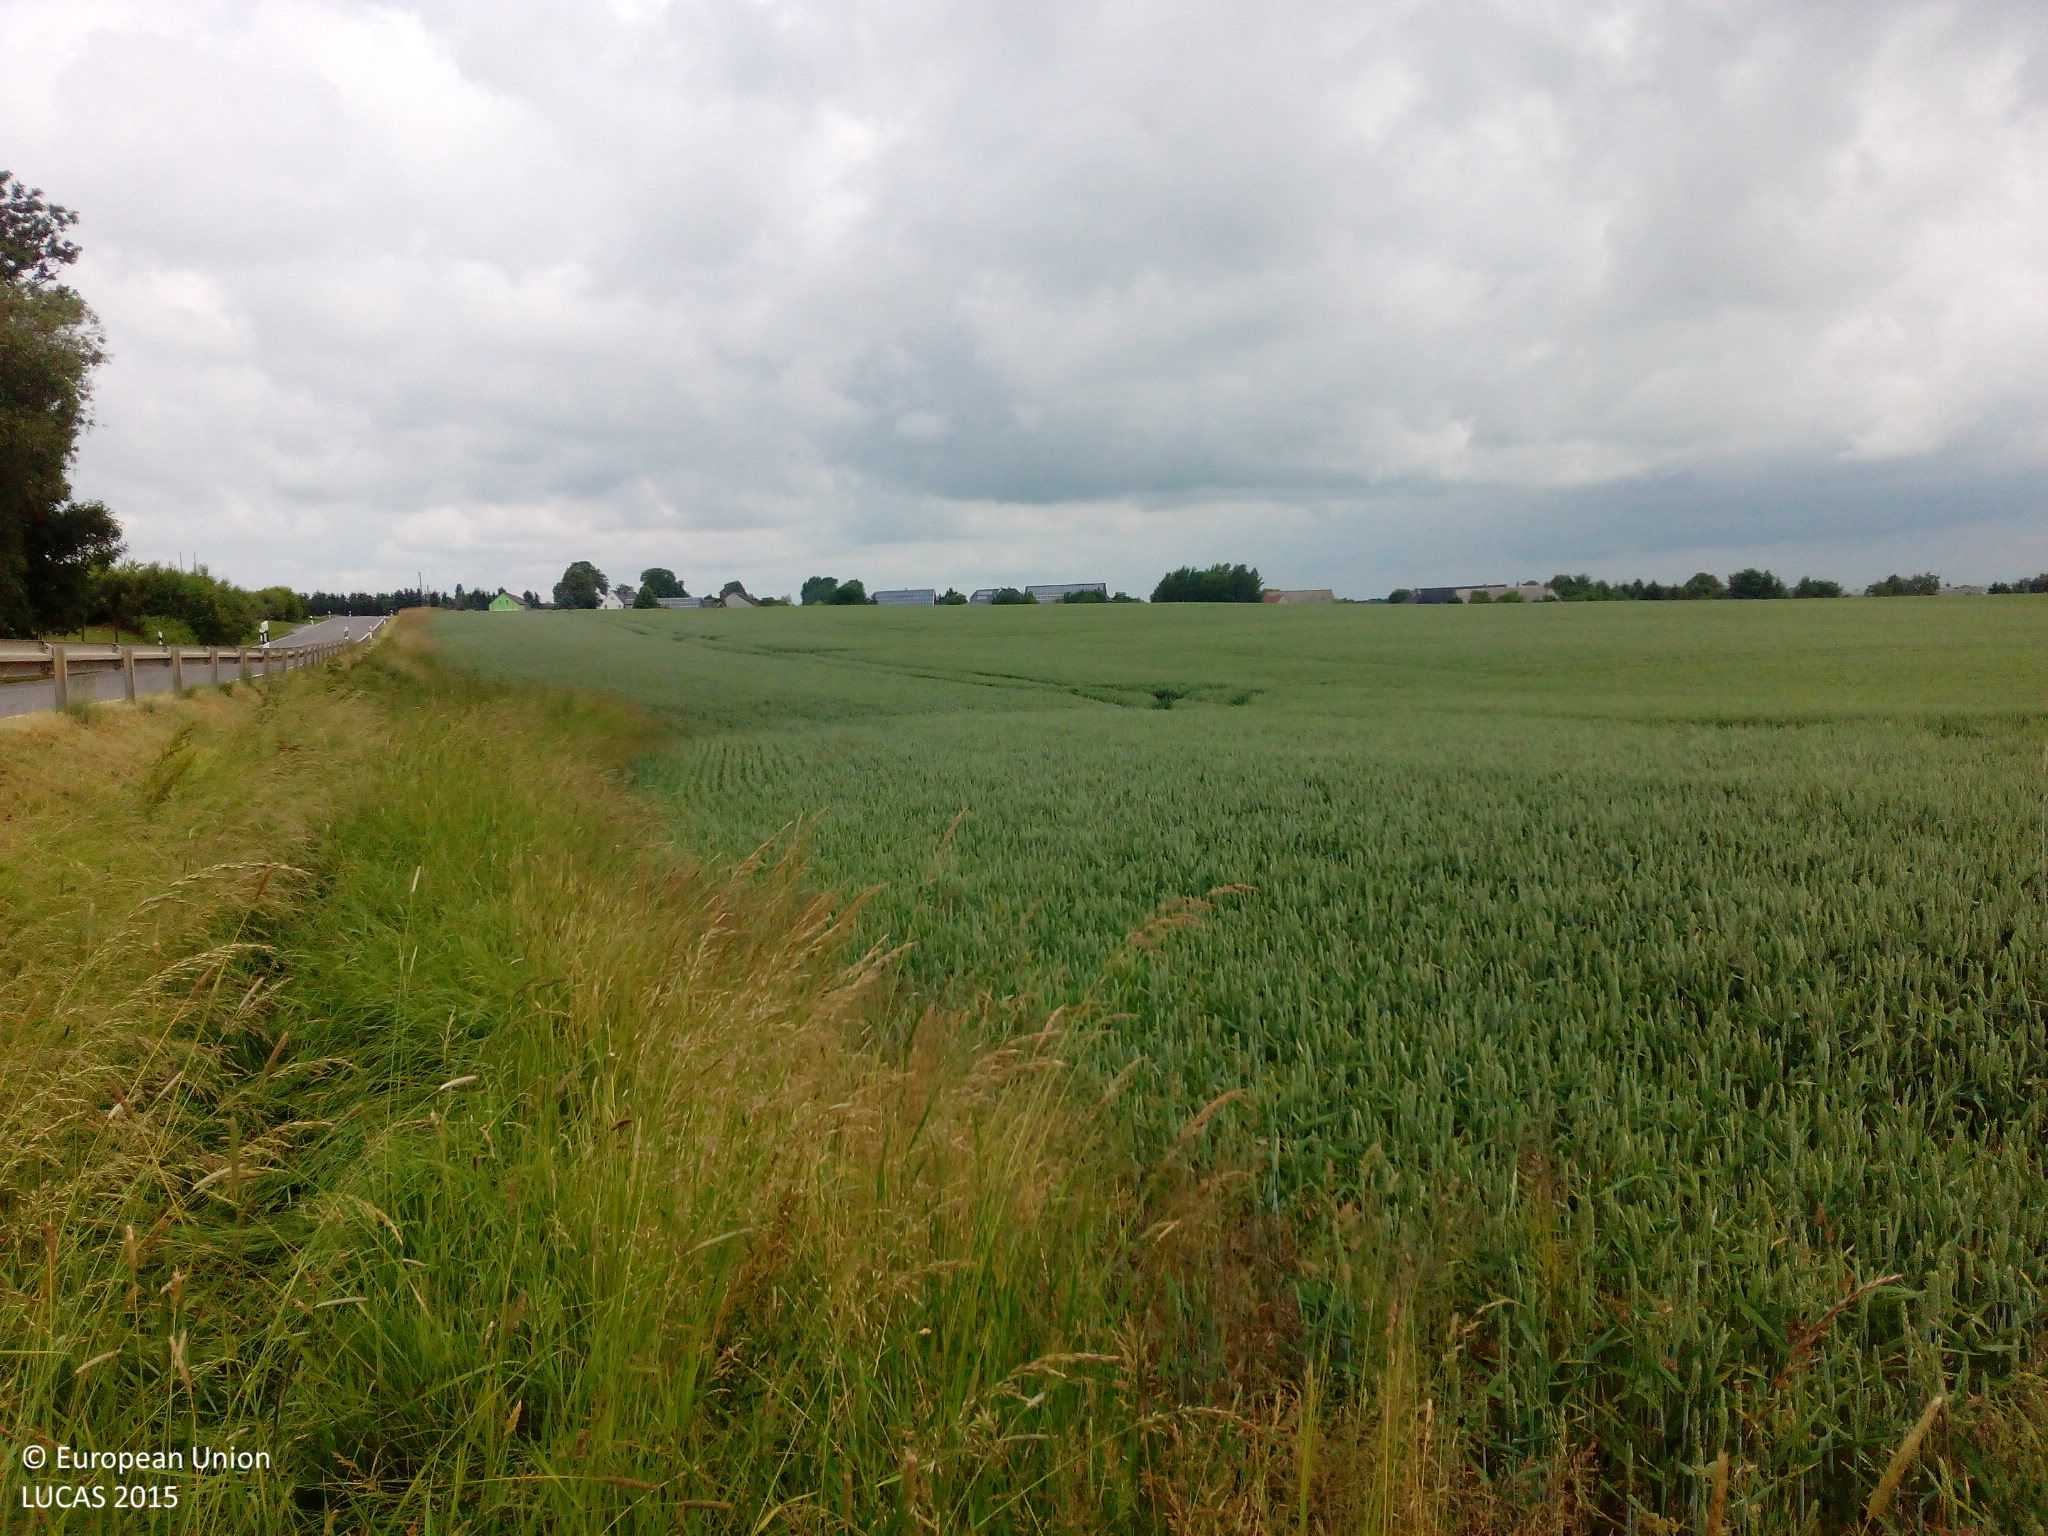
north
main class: Cropland
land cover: Common wheat
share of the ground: > 75 %
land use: Agriculture (excluding fallow land and kitchen gardens)
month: June
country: DE
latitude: 51.0419
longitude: 13.0951
